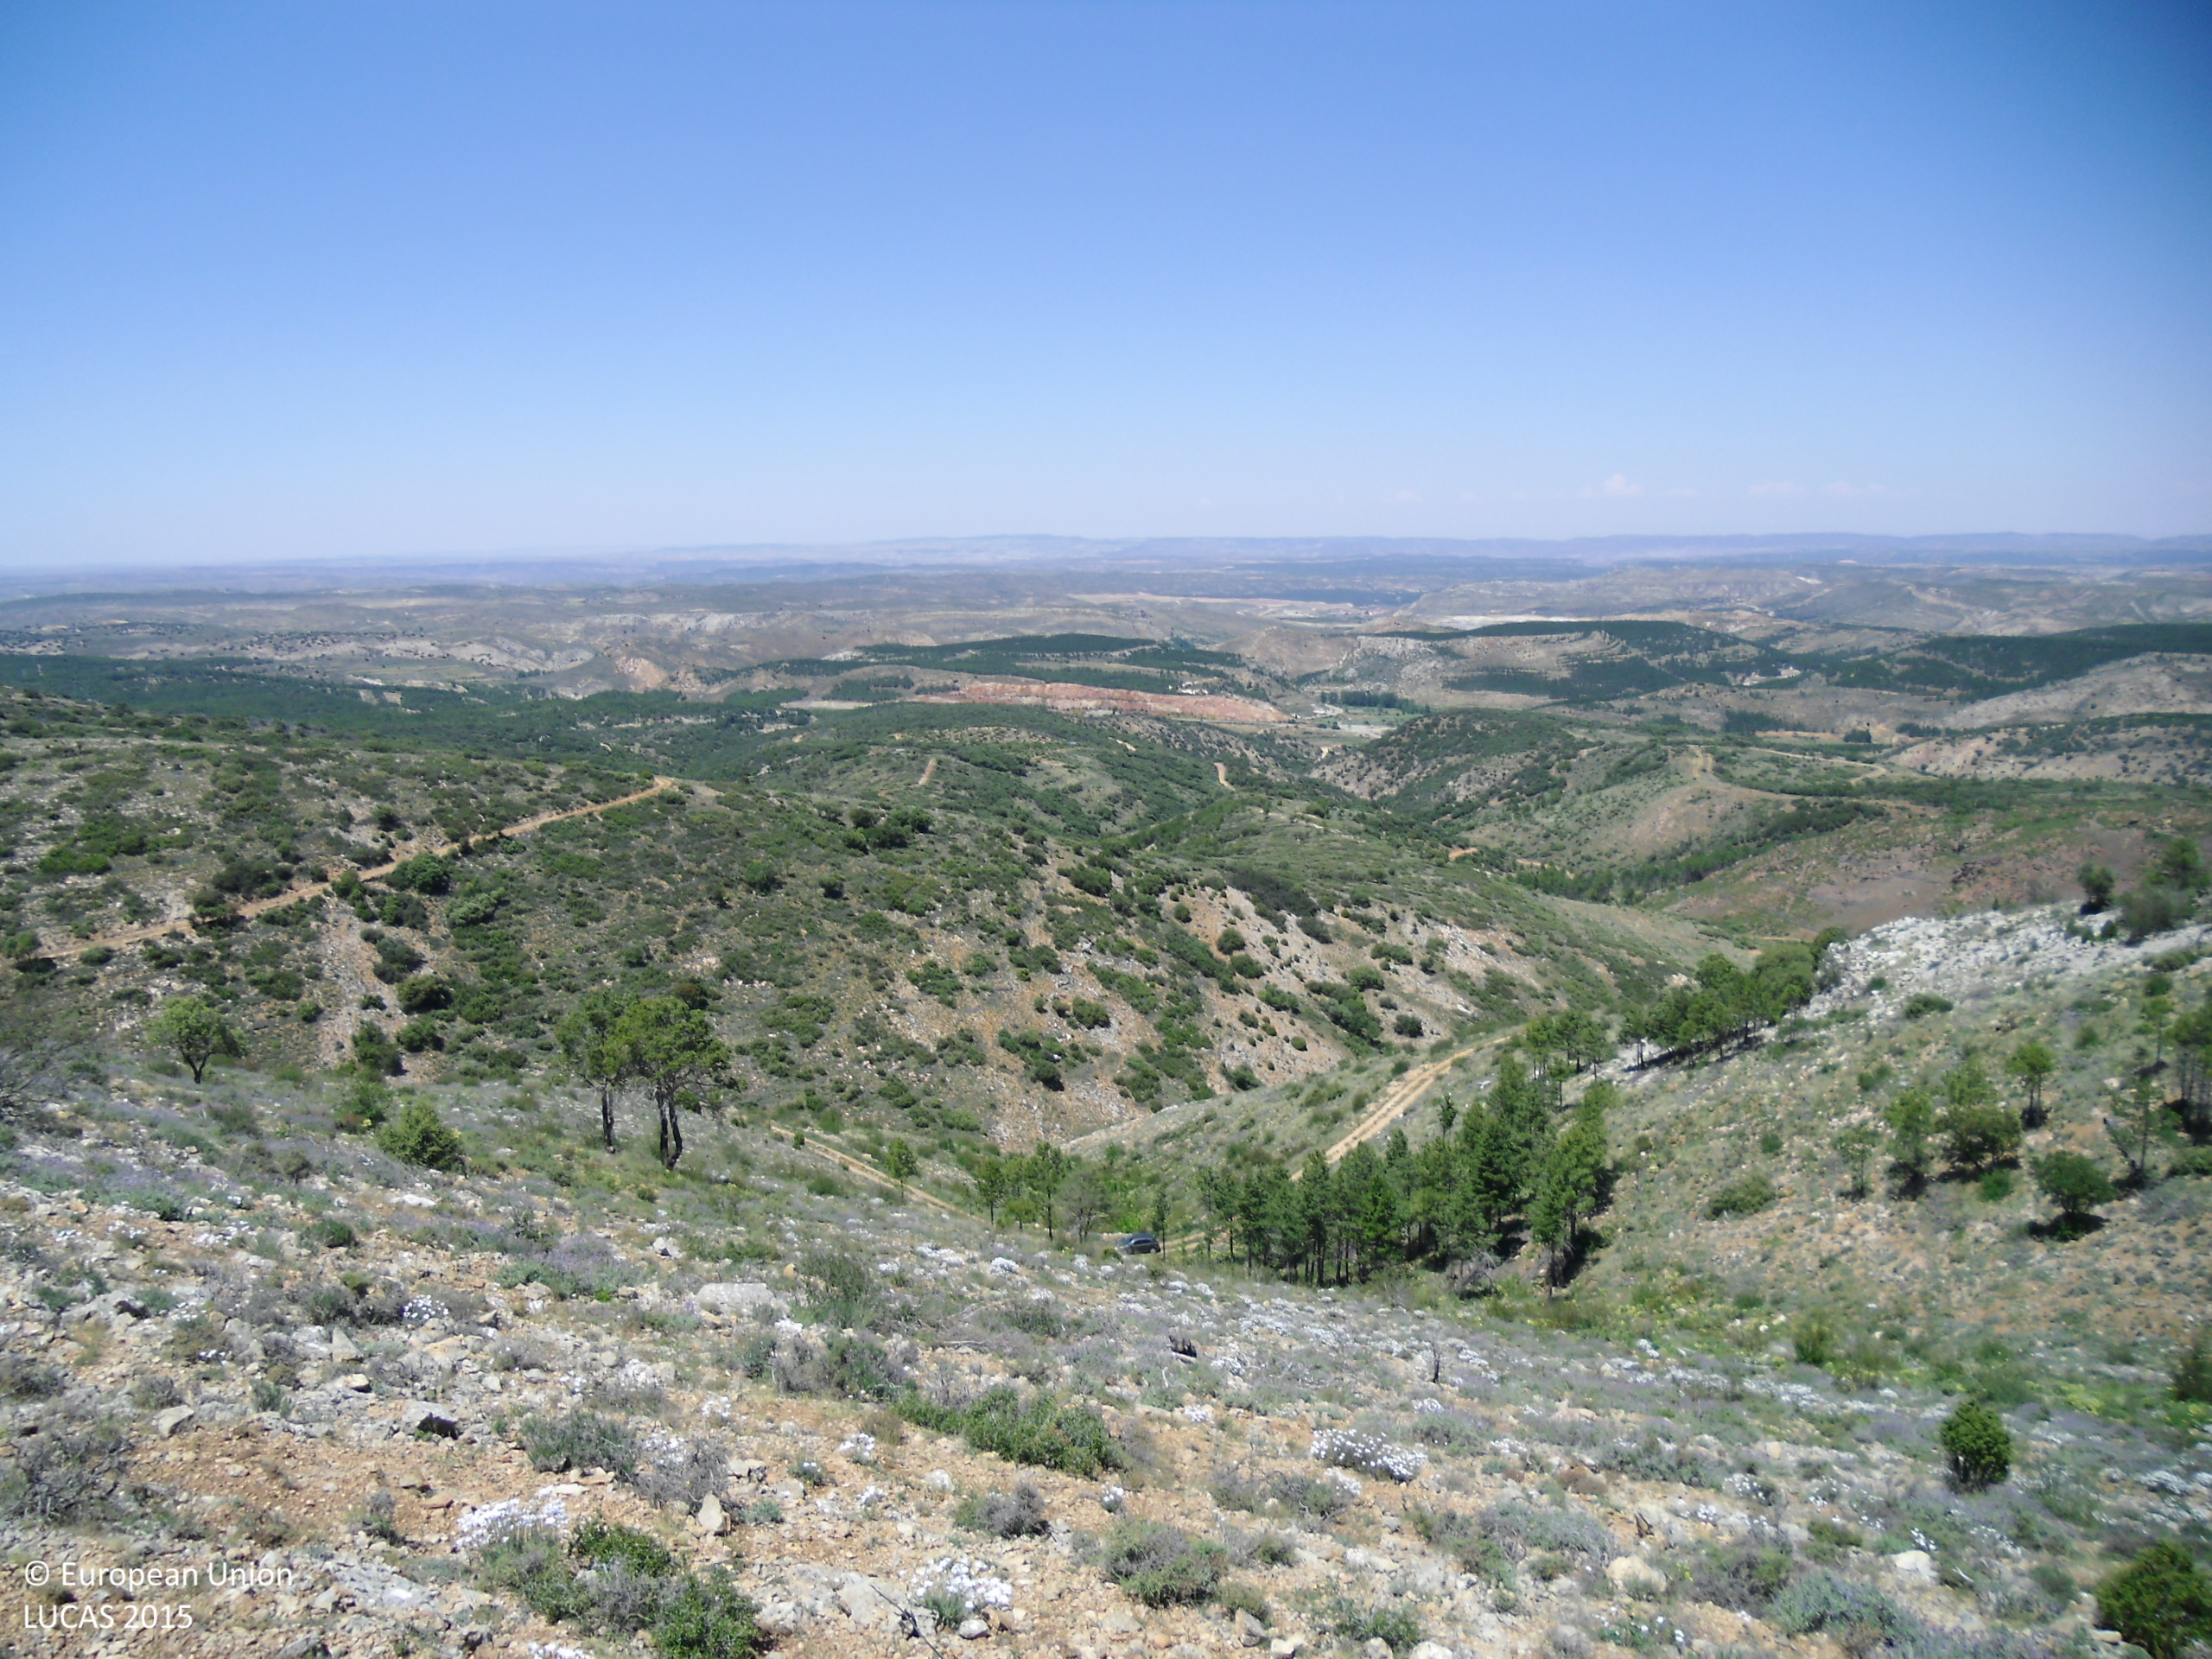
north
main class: Shrubland
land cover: Shrubland without tree cover
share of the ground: 10 - 25 %
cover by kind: consolidated bare surface 80 %, shrubs 15 %, herbaceous plants 5 %
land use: Semi-natural and natural areas not in use
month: June
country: ES
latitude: 40.7807
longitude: -0.6407
